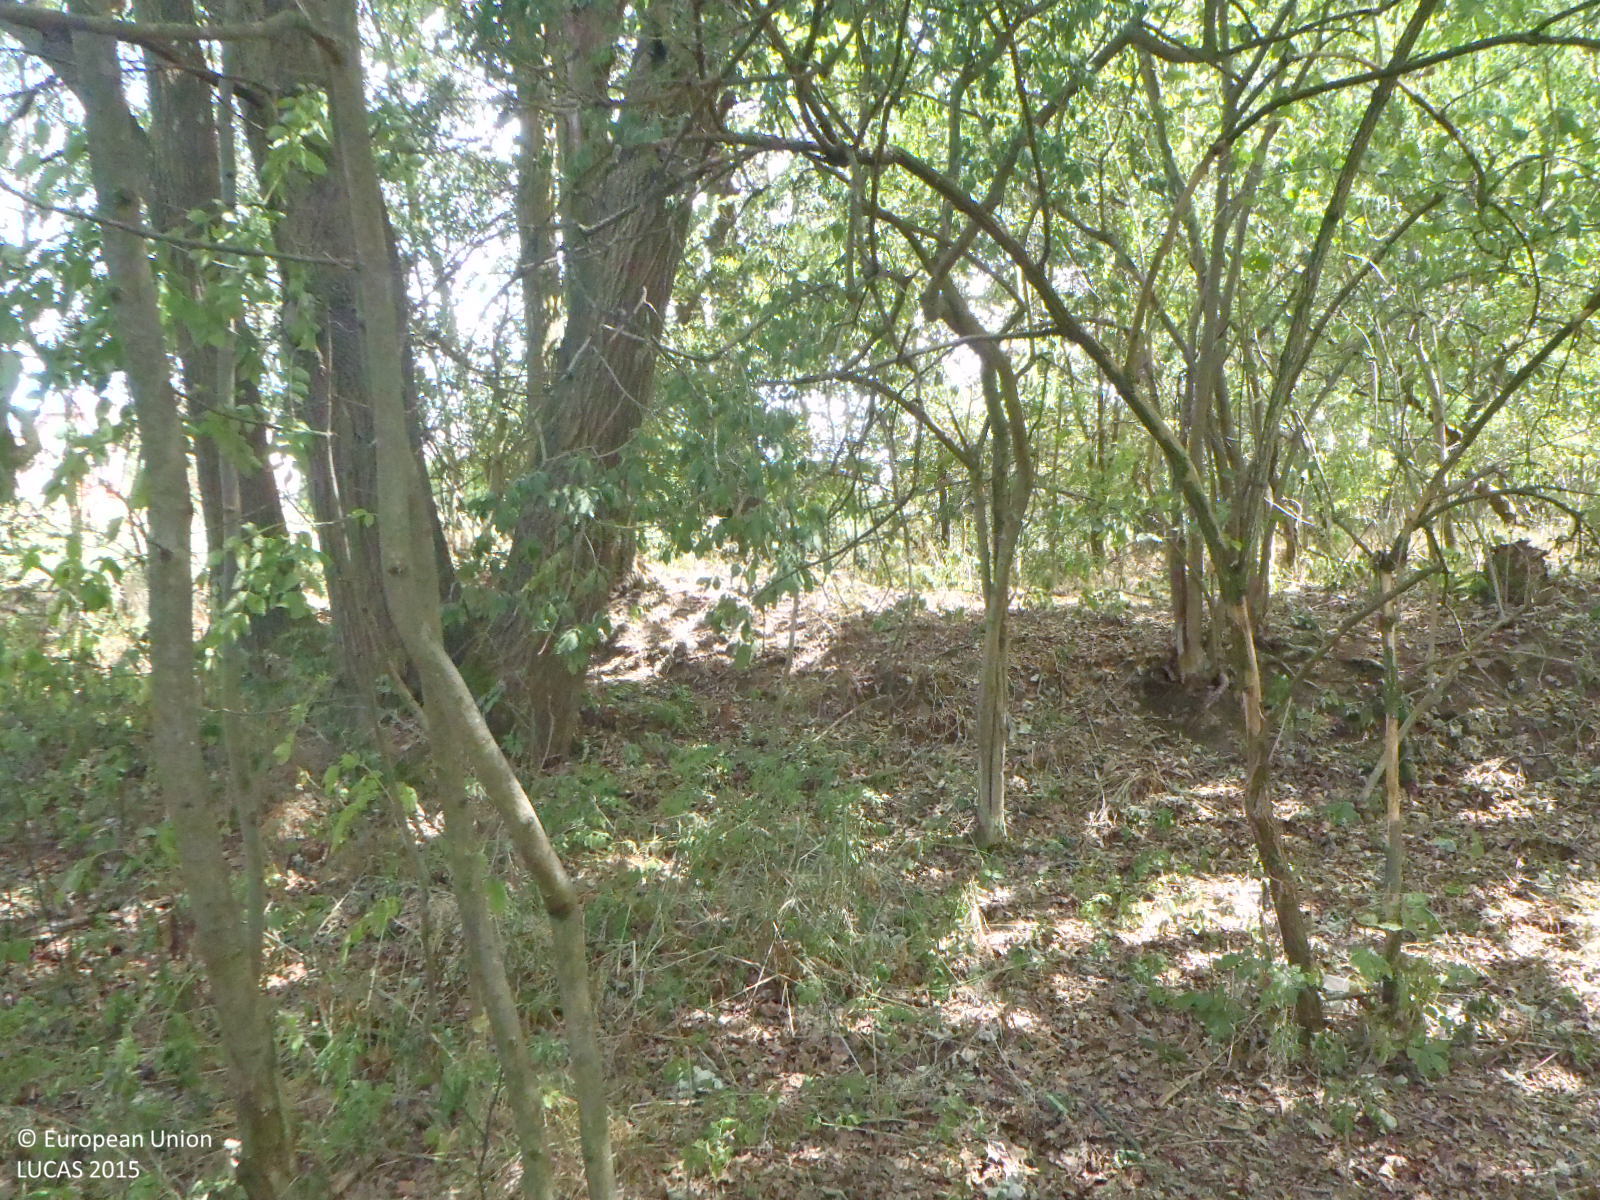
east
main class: Woodland
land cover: Broadleaved woodland
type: mesophytic deciduous forest
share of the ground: > 75 %
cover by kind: broadleaved forest trees 95 %, shrubs 5 %
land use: Forestry
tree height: > 5 m
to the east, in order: Broadleaved woodland; Grassland without tree/shrub cover; Spontaneously vegetated surfaces; Artificial constructions in urban areas; Other fruit trees and berries; Grassland without tree/shrub cover; Ditches and canals; Grassland without tree/shrub cover
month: July
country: CZ
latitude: 49.0337
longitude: 14.4739
